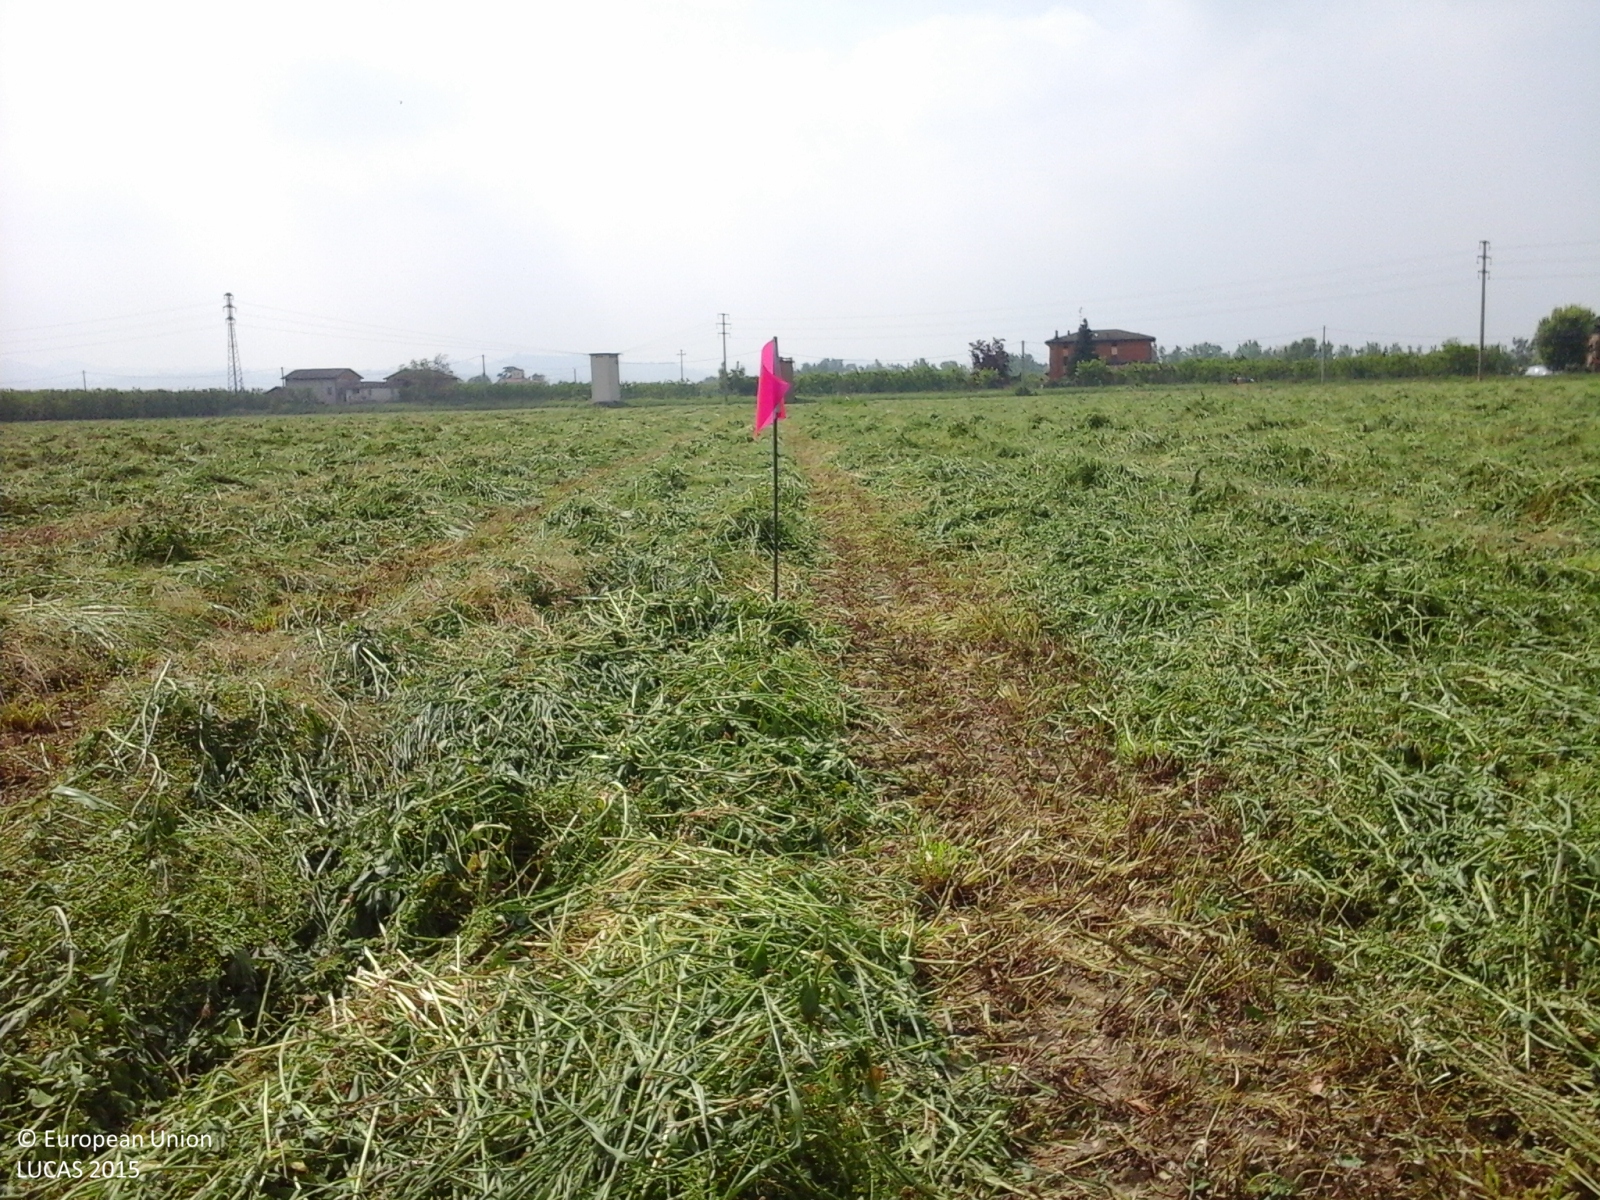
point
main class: Cropland
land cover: Lucerne
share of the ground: 10 - 25 %
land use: Agriculture (excluding fallow land and kitchen gardens)
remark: Harvested field
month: May
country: IT
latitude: 44.5257
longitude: 11.0421
